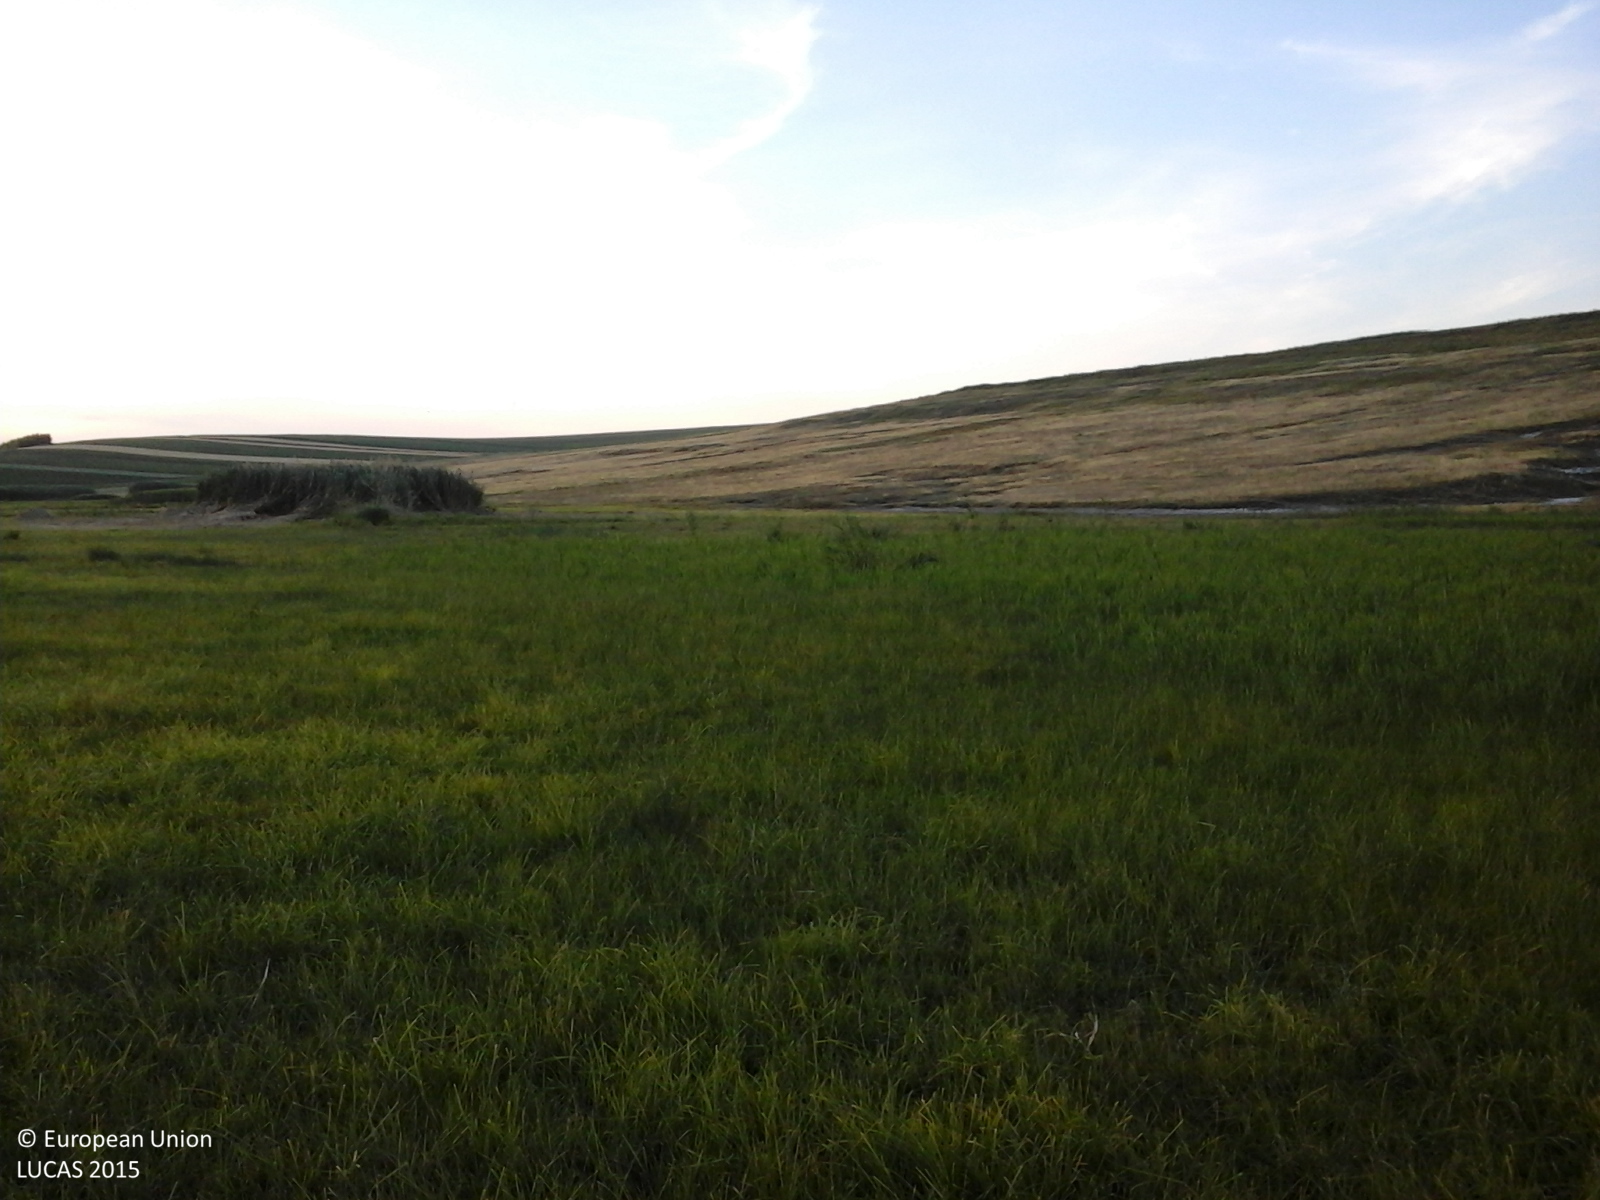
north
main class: Grassland
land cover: Grassland without tree/shrub cover
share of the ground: > 75 %
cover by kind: herbaceous plants 100 %
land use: Agriculture (excluding fallow land and kitchen gardens)
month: June
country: RO
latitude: 47.4411
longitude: 27.1194
